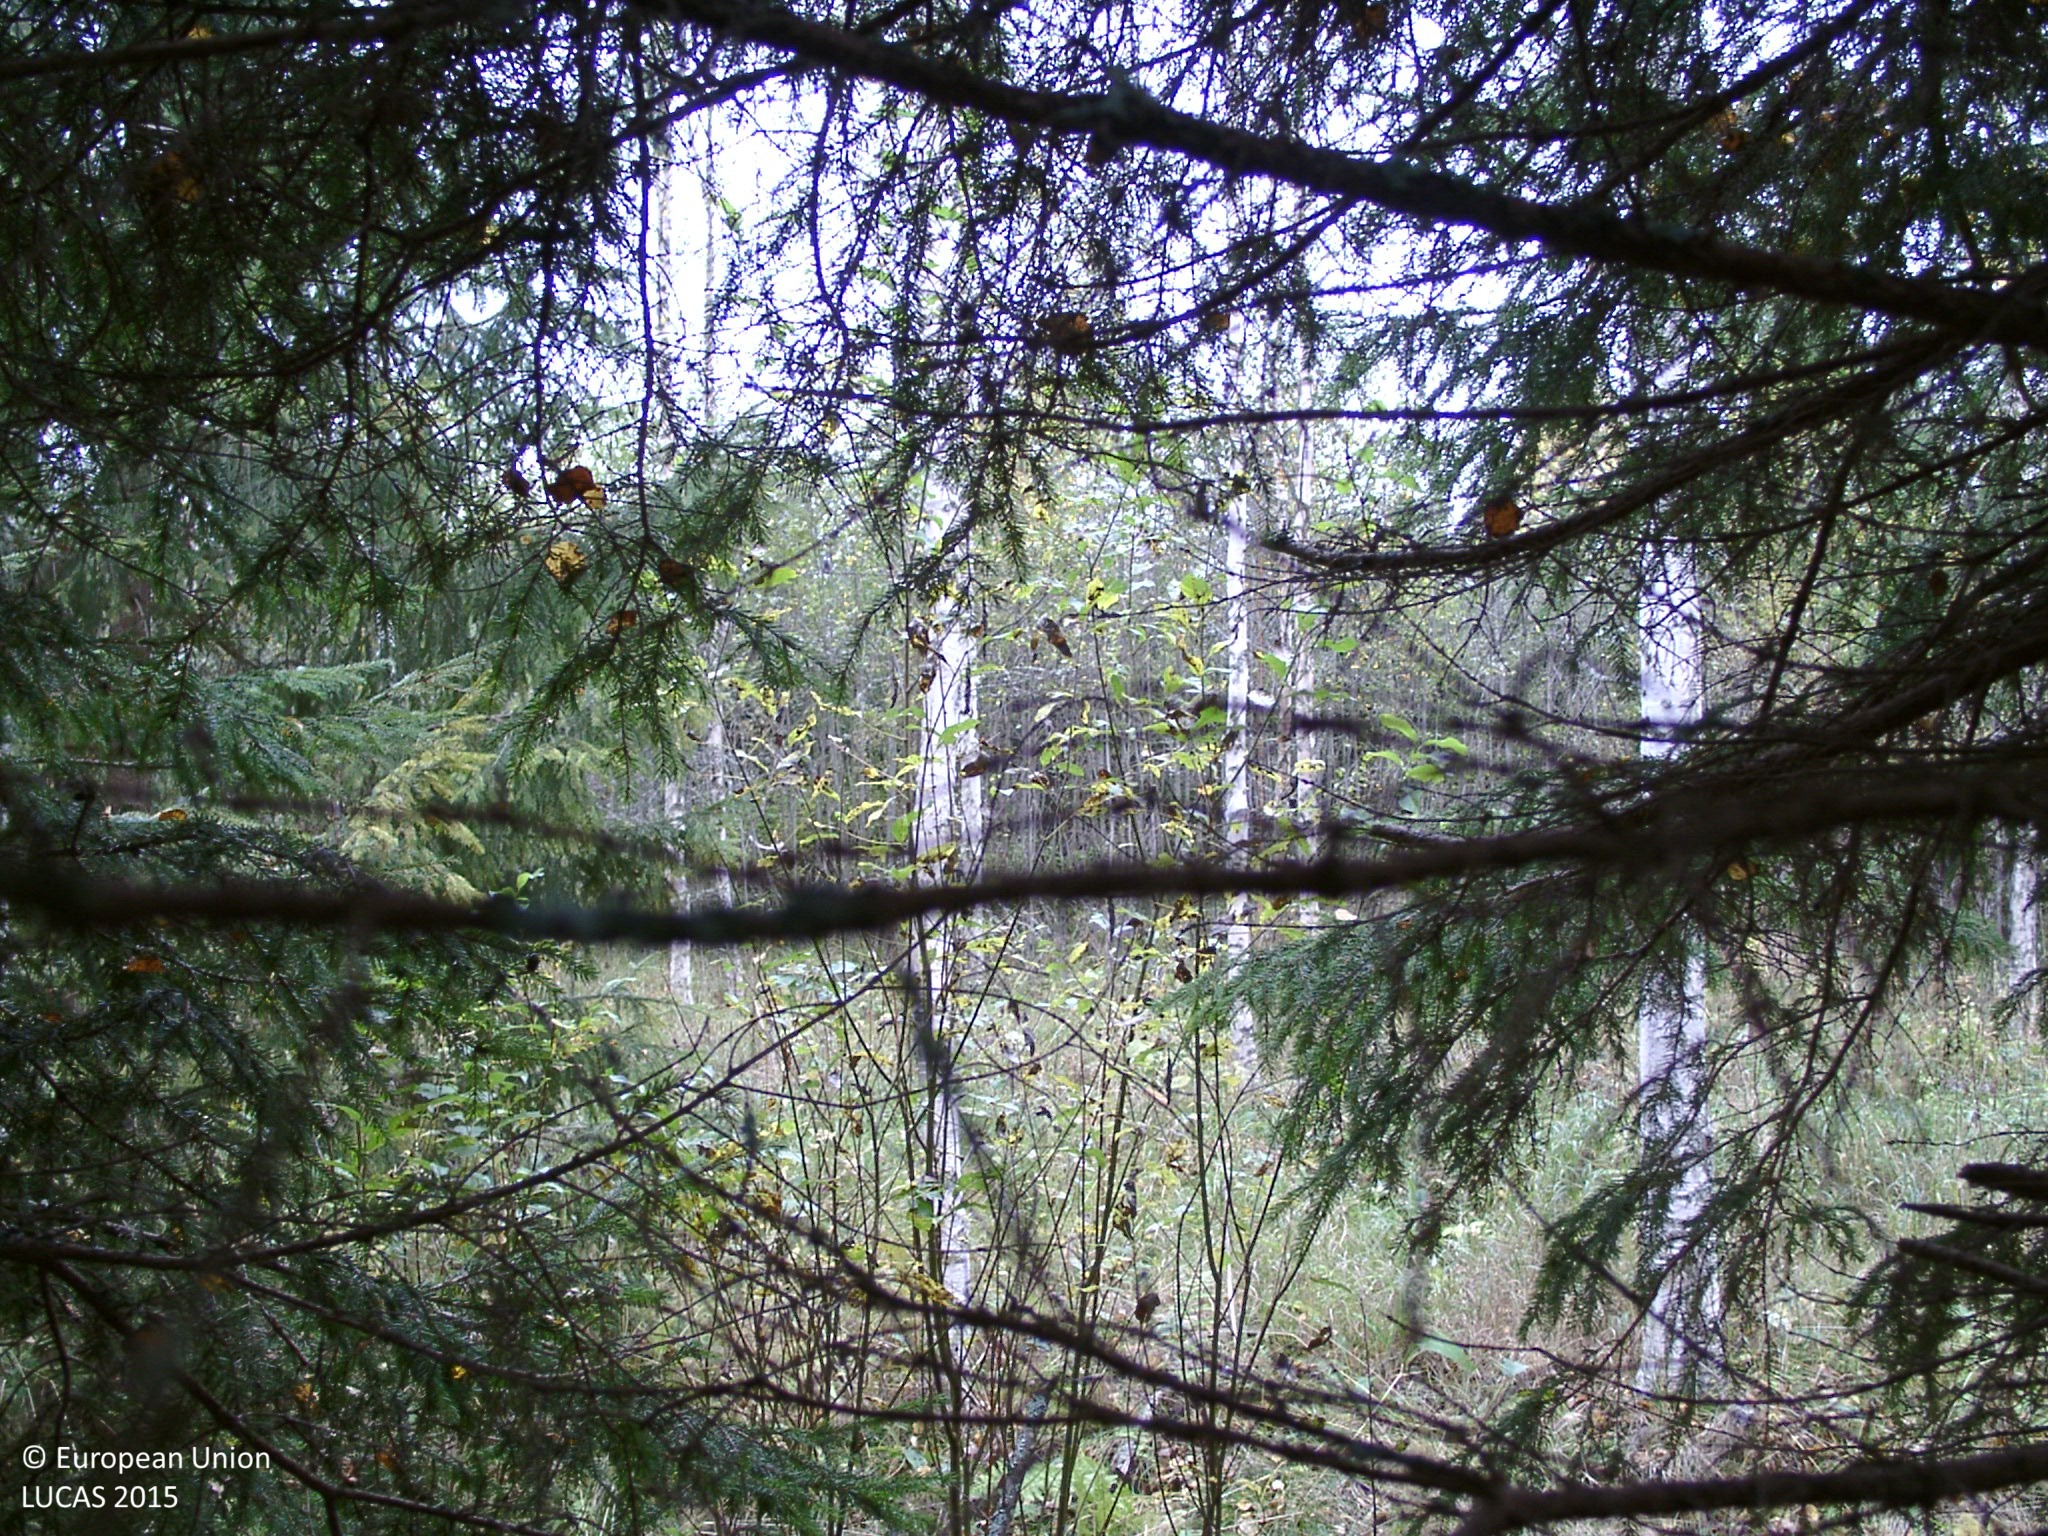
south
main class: Woodland
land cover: Spruce dominated coniferous woodland
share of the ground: > 75 %
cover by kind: coniferous forest trees 85 %, shrubs 5 %, herbaceous plants 5 %, lichens and mosses 5 %
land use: Forestry
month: September
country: FI
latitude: 62.6312
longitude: 25.3347
